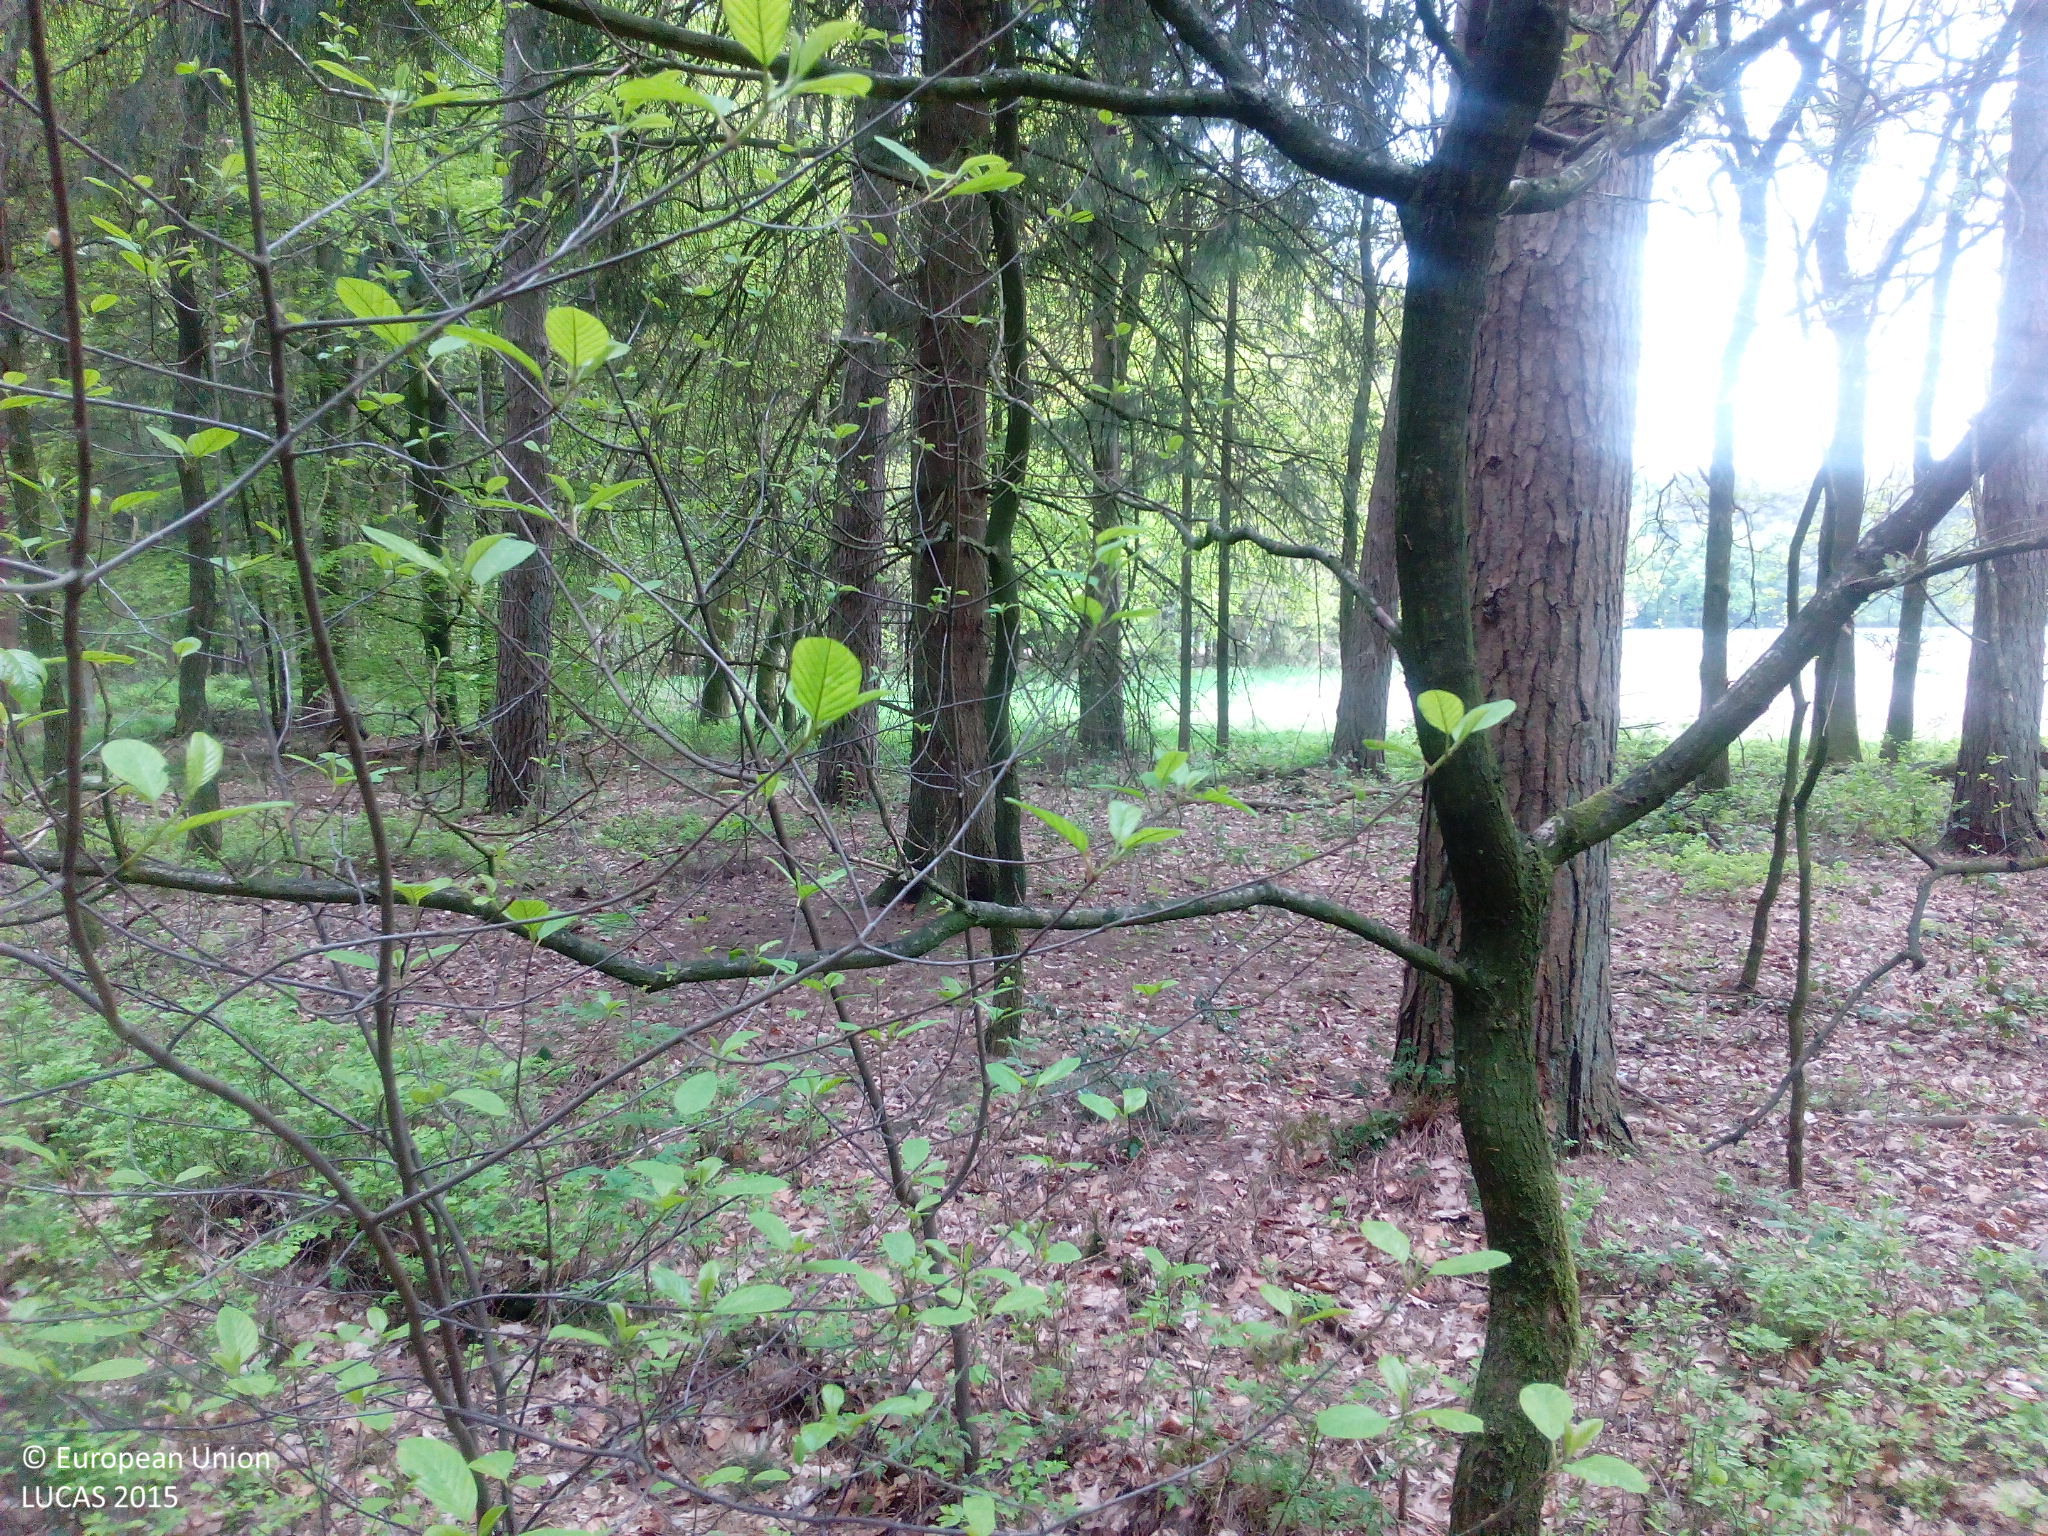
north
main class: Woodland
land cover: Other mixed woodland
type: hemiboreal forest and nemoral coniferous forest and mixed broadleaved-coniferous forest
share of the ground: > 75 %
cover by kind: coniferous forest trees 60 %, broadleaved forest trees 25 %, herbaceous plants 15 %
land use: Forestry
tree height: > 5 m
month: May
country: DE
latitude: 53.2014
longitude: 9.1770
